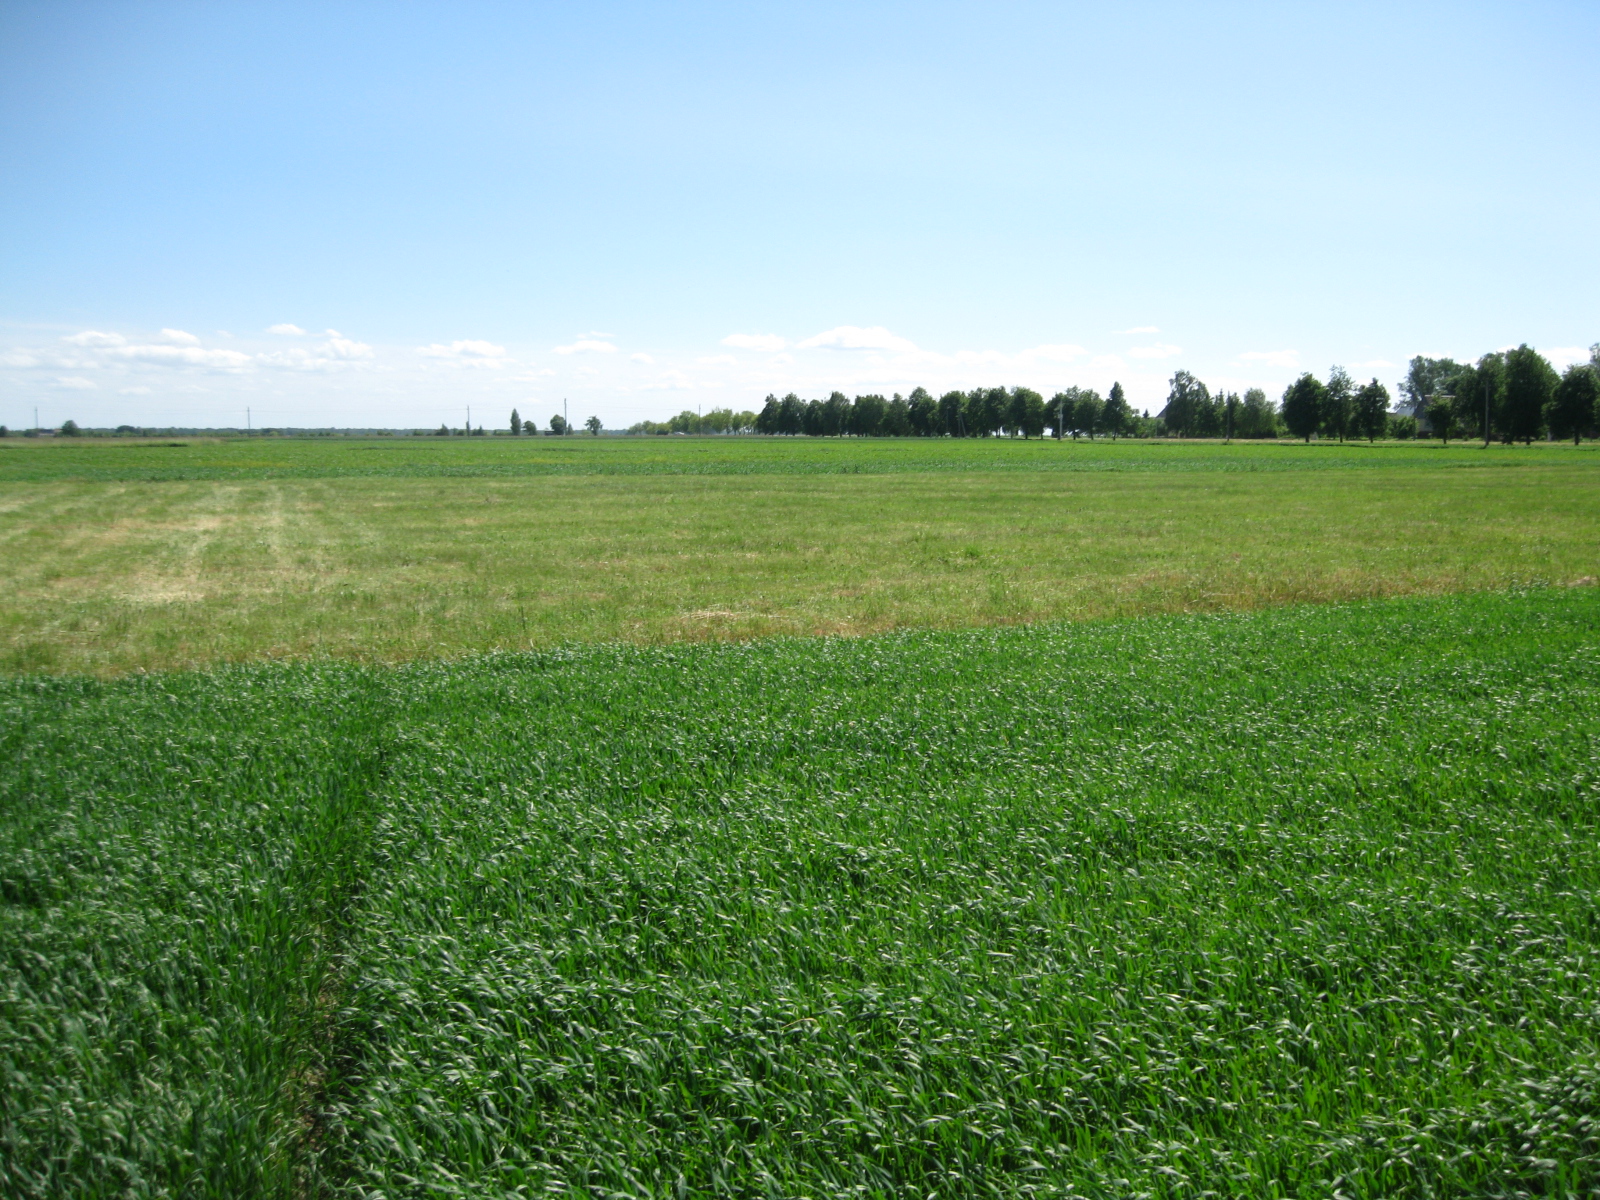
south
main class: Cropland
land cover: Triticale
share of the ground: > 75 %
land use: Agriculture (excluding fallow land and kitchen gardens)
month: June
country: LT
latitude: 55.2771
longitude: 23.9254
